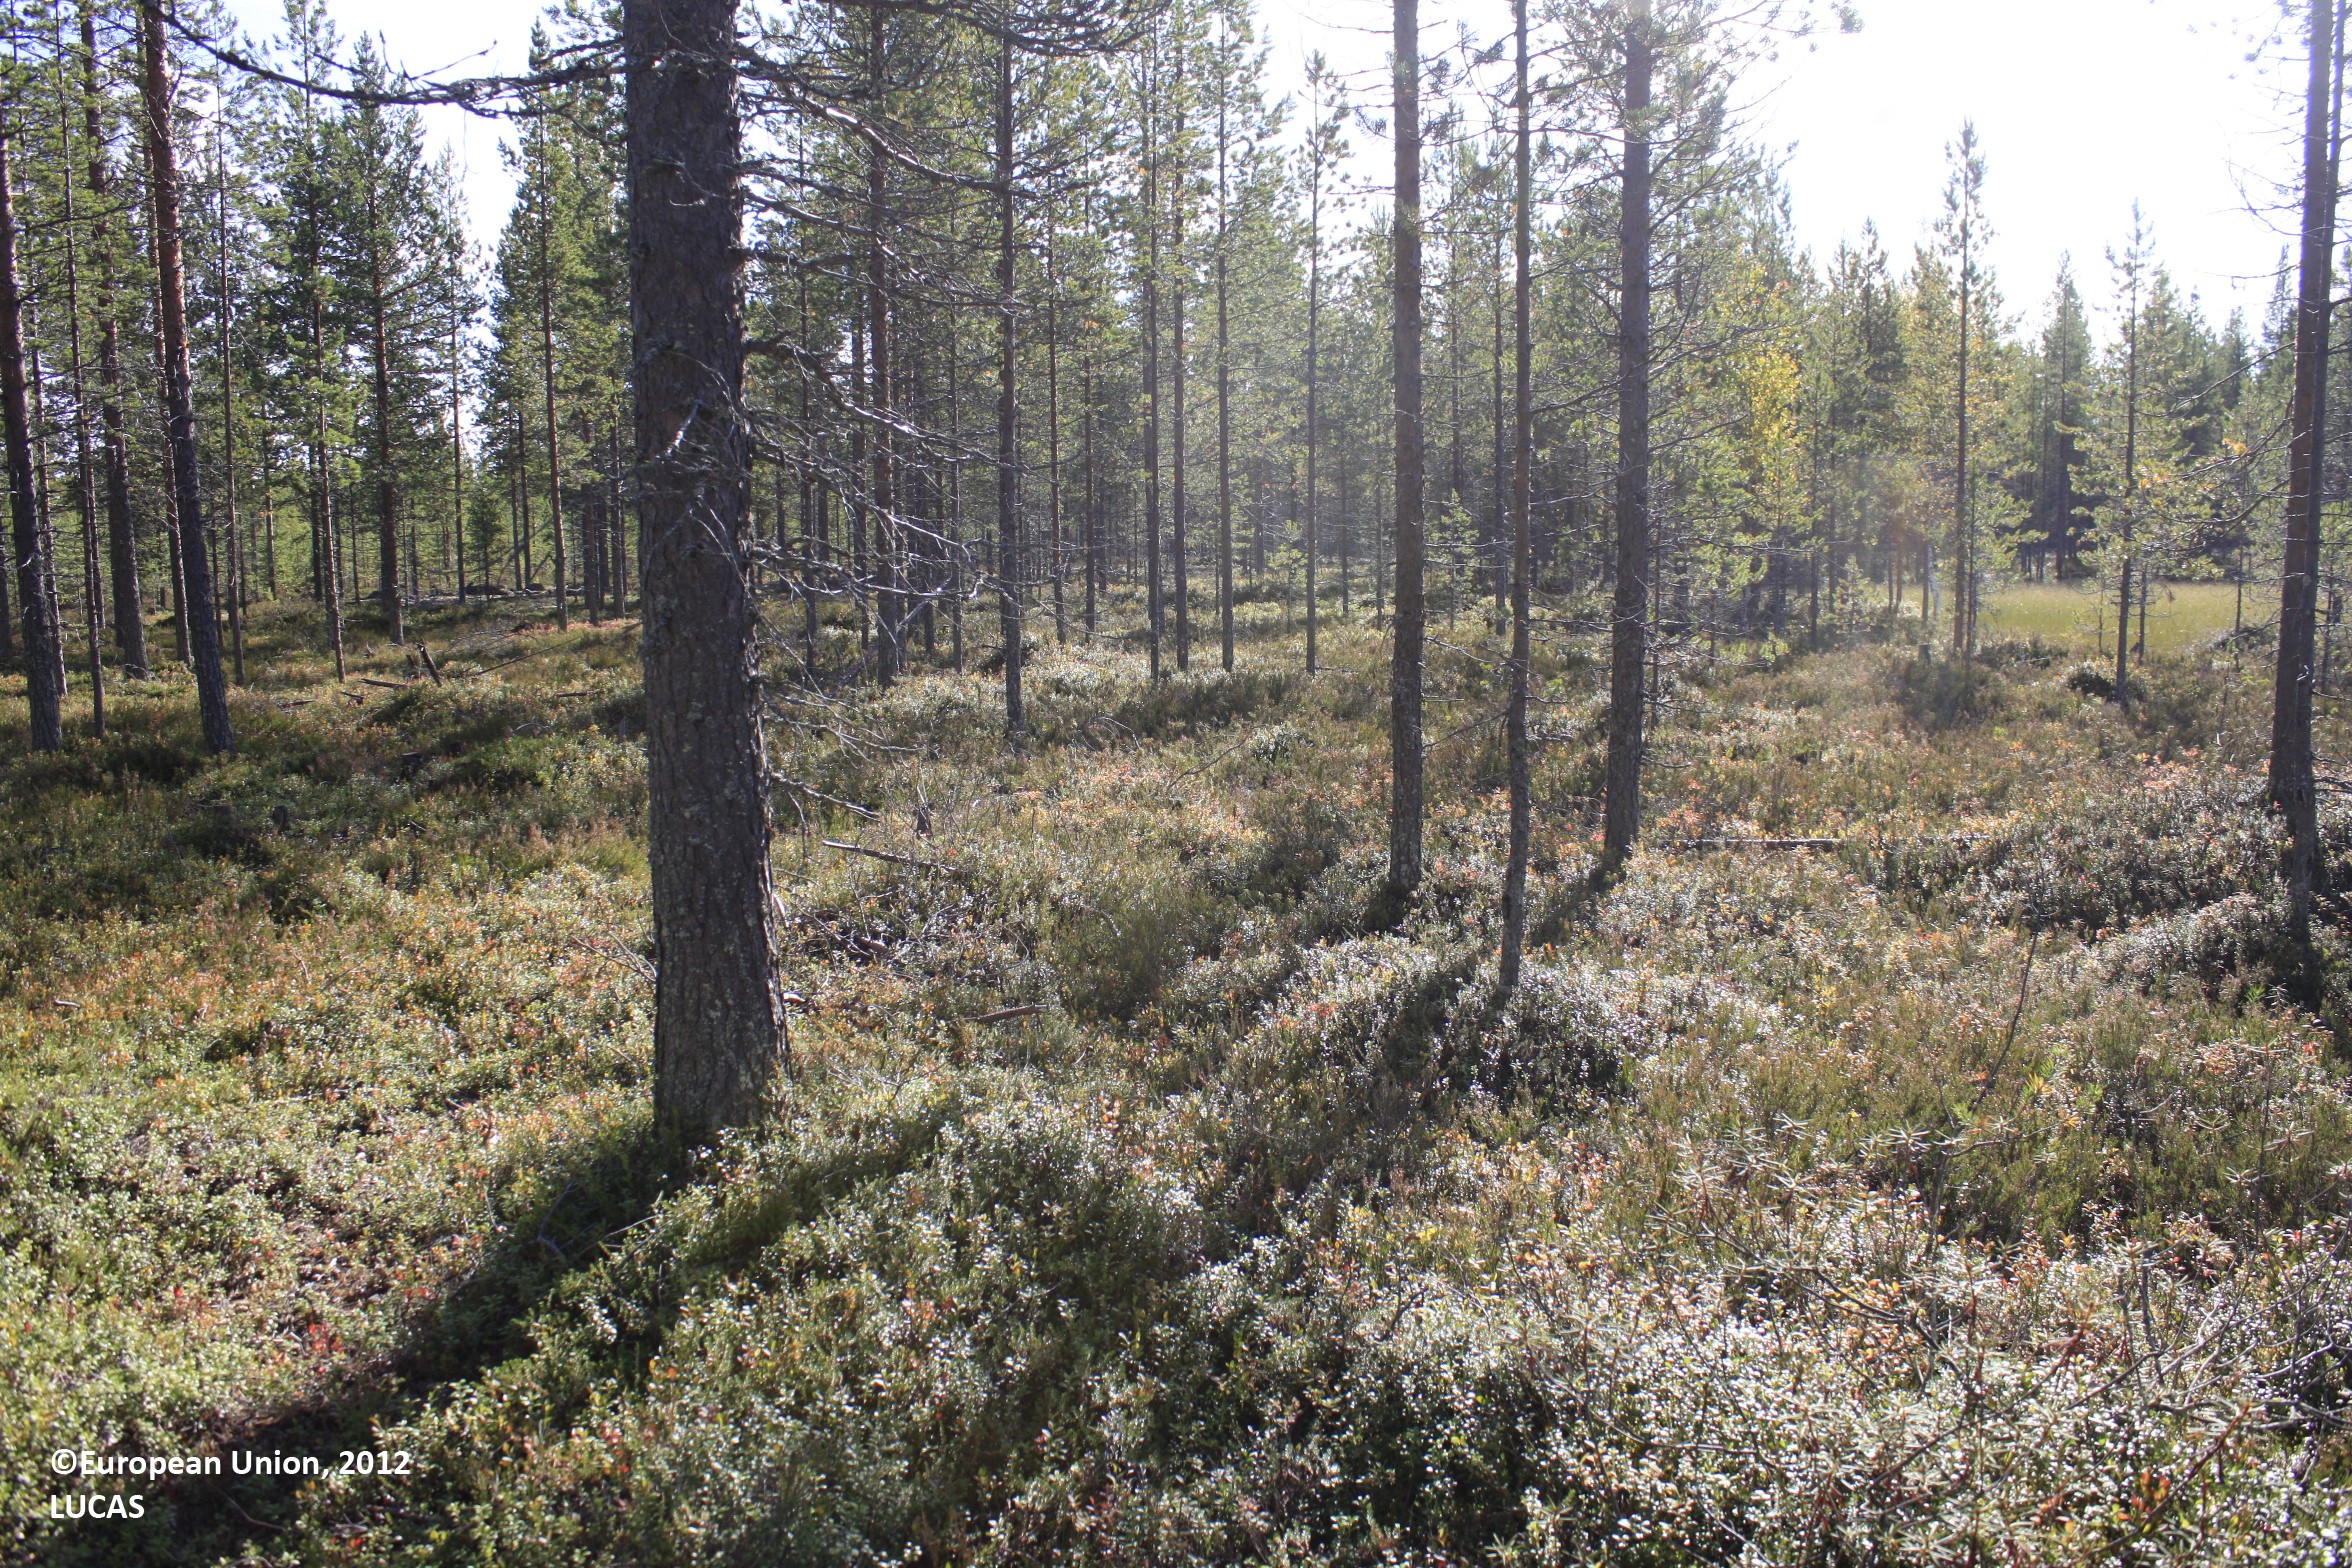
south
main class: Woodland
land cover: Pine dominated coniferous woodland
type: boreal forest
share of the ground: < 10 %
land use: Forestry
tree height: > 5 m
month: September
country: FI
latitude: 65.5018
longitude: 26.9497
